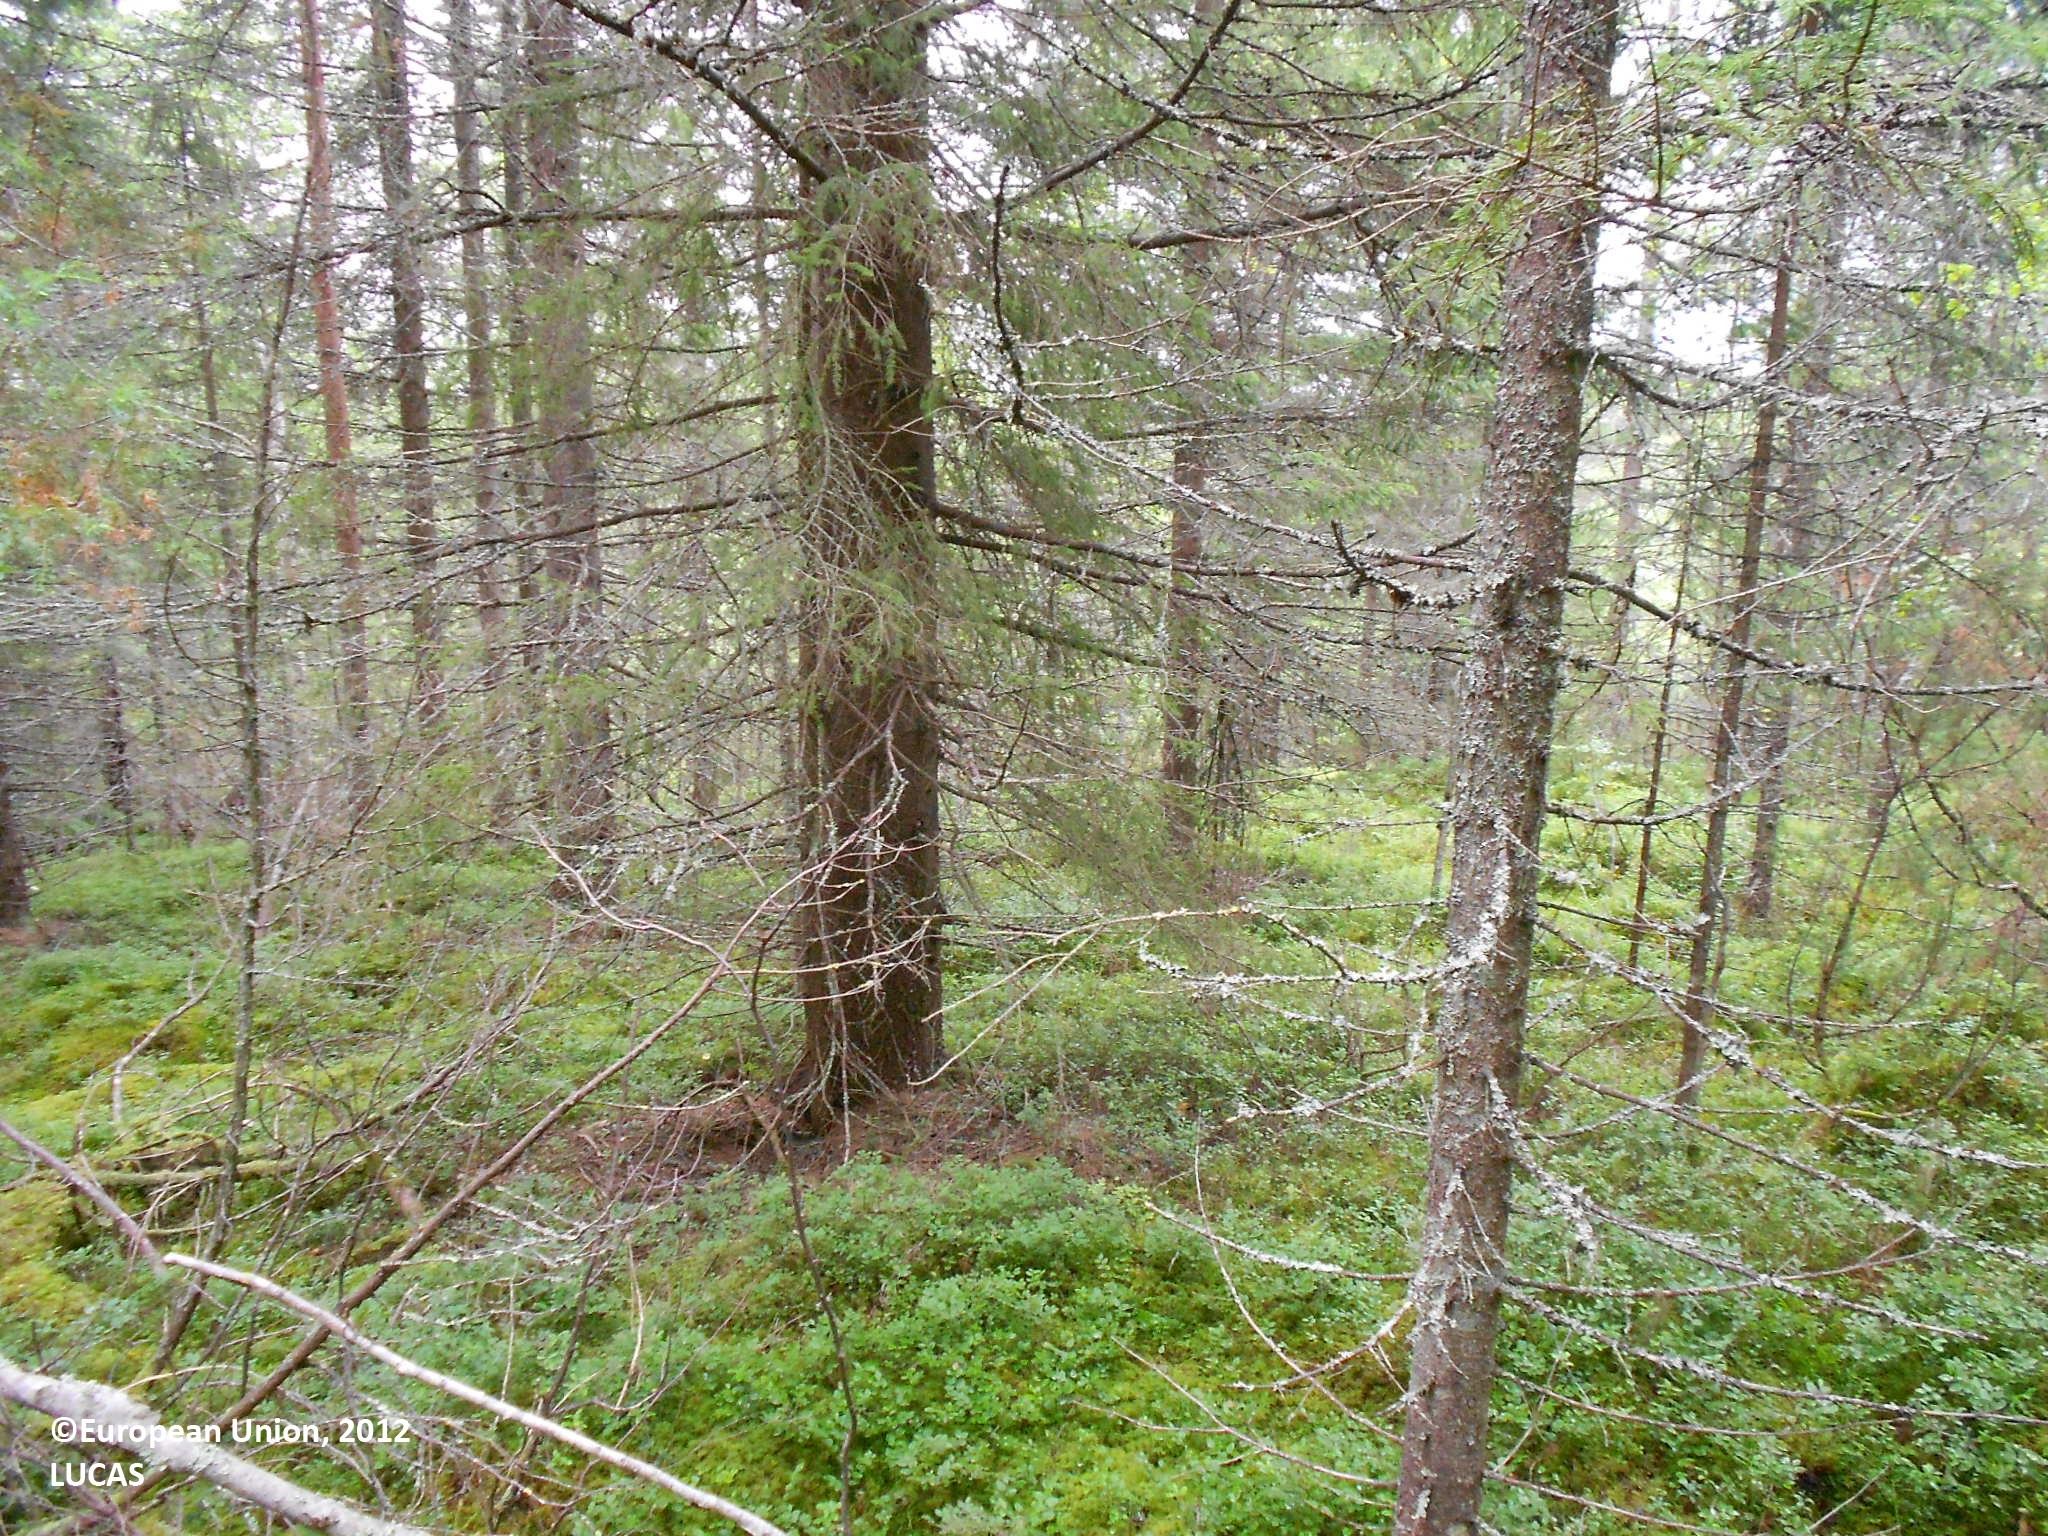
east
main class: Woodland
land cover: Spruce dominated coniferous woodland
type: boreal forest
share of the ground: > 75 %
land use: Forestry
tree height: > 5 m
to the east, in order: Spruce dominated coniferous woodland; Pine dominated coniferous woodland
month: August
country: FI
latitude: 63.4656
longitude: 28.9247
